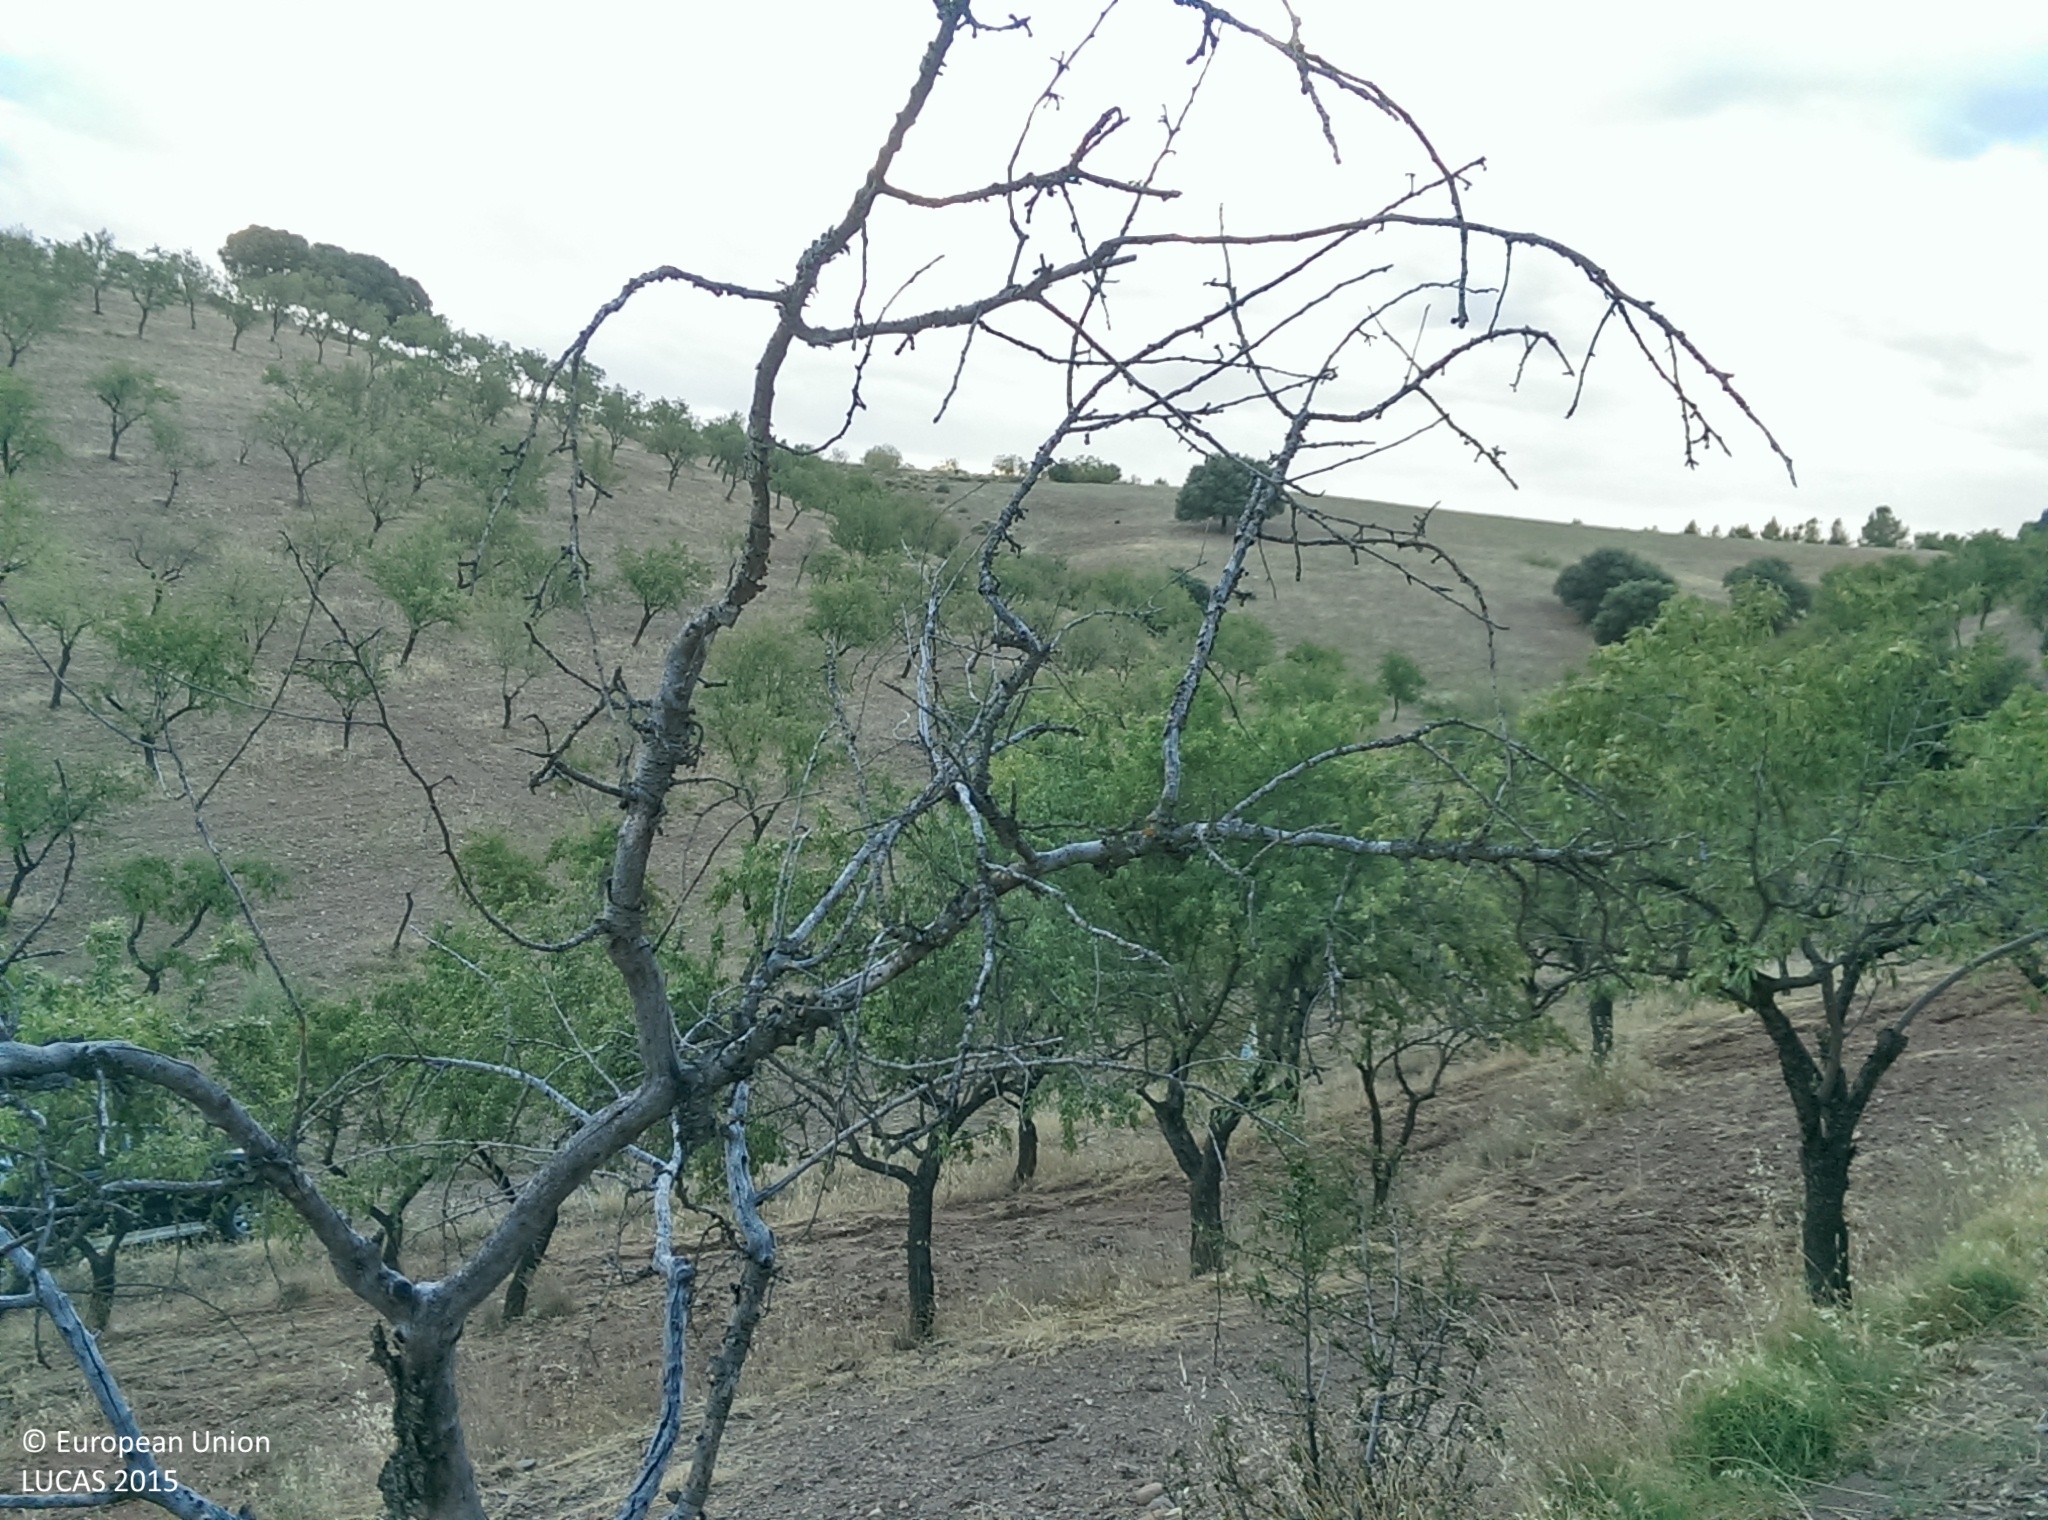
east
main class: Cropland
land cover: Nuts trees
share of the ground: 25 - 50 %
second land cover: Other bare soil
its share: > 75 %
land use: Agriculture (excluding fallow land and kitchen gardens)
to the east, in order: Nuts trees; Other bare soil; Grassland with sparse tree/shrub cover; Tracks; Grassland with sparse tree/shrub cover; Nuts trees; Shrubland with sparse tree cover; Grassland without tree/shrub cover
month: July
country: ES
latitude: 37.2731
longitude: -3.2613
